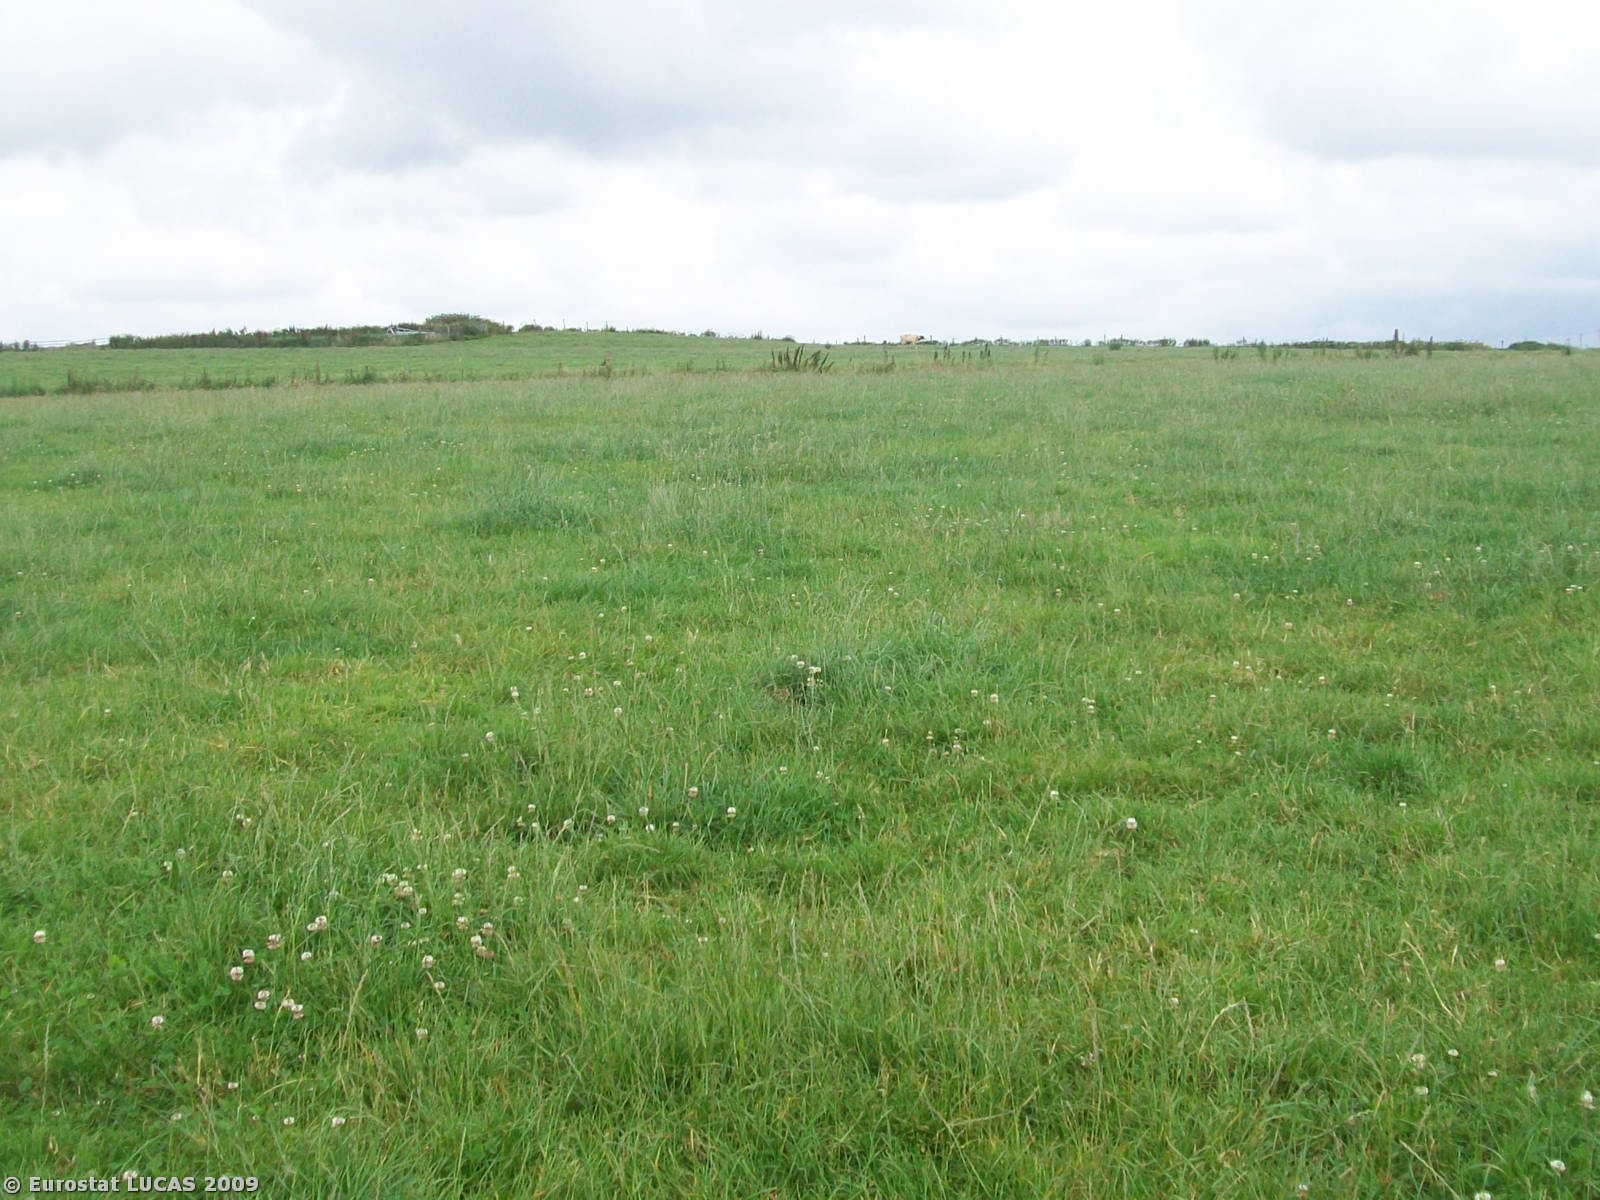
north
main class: Grassland
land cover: Grassland without tree/shrub cover
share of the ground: > 75 %
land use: Agriculture (excluding fallow land and kitchen gardens)
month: July
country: GB
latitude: 50.9252
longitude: -2.7175
